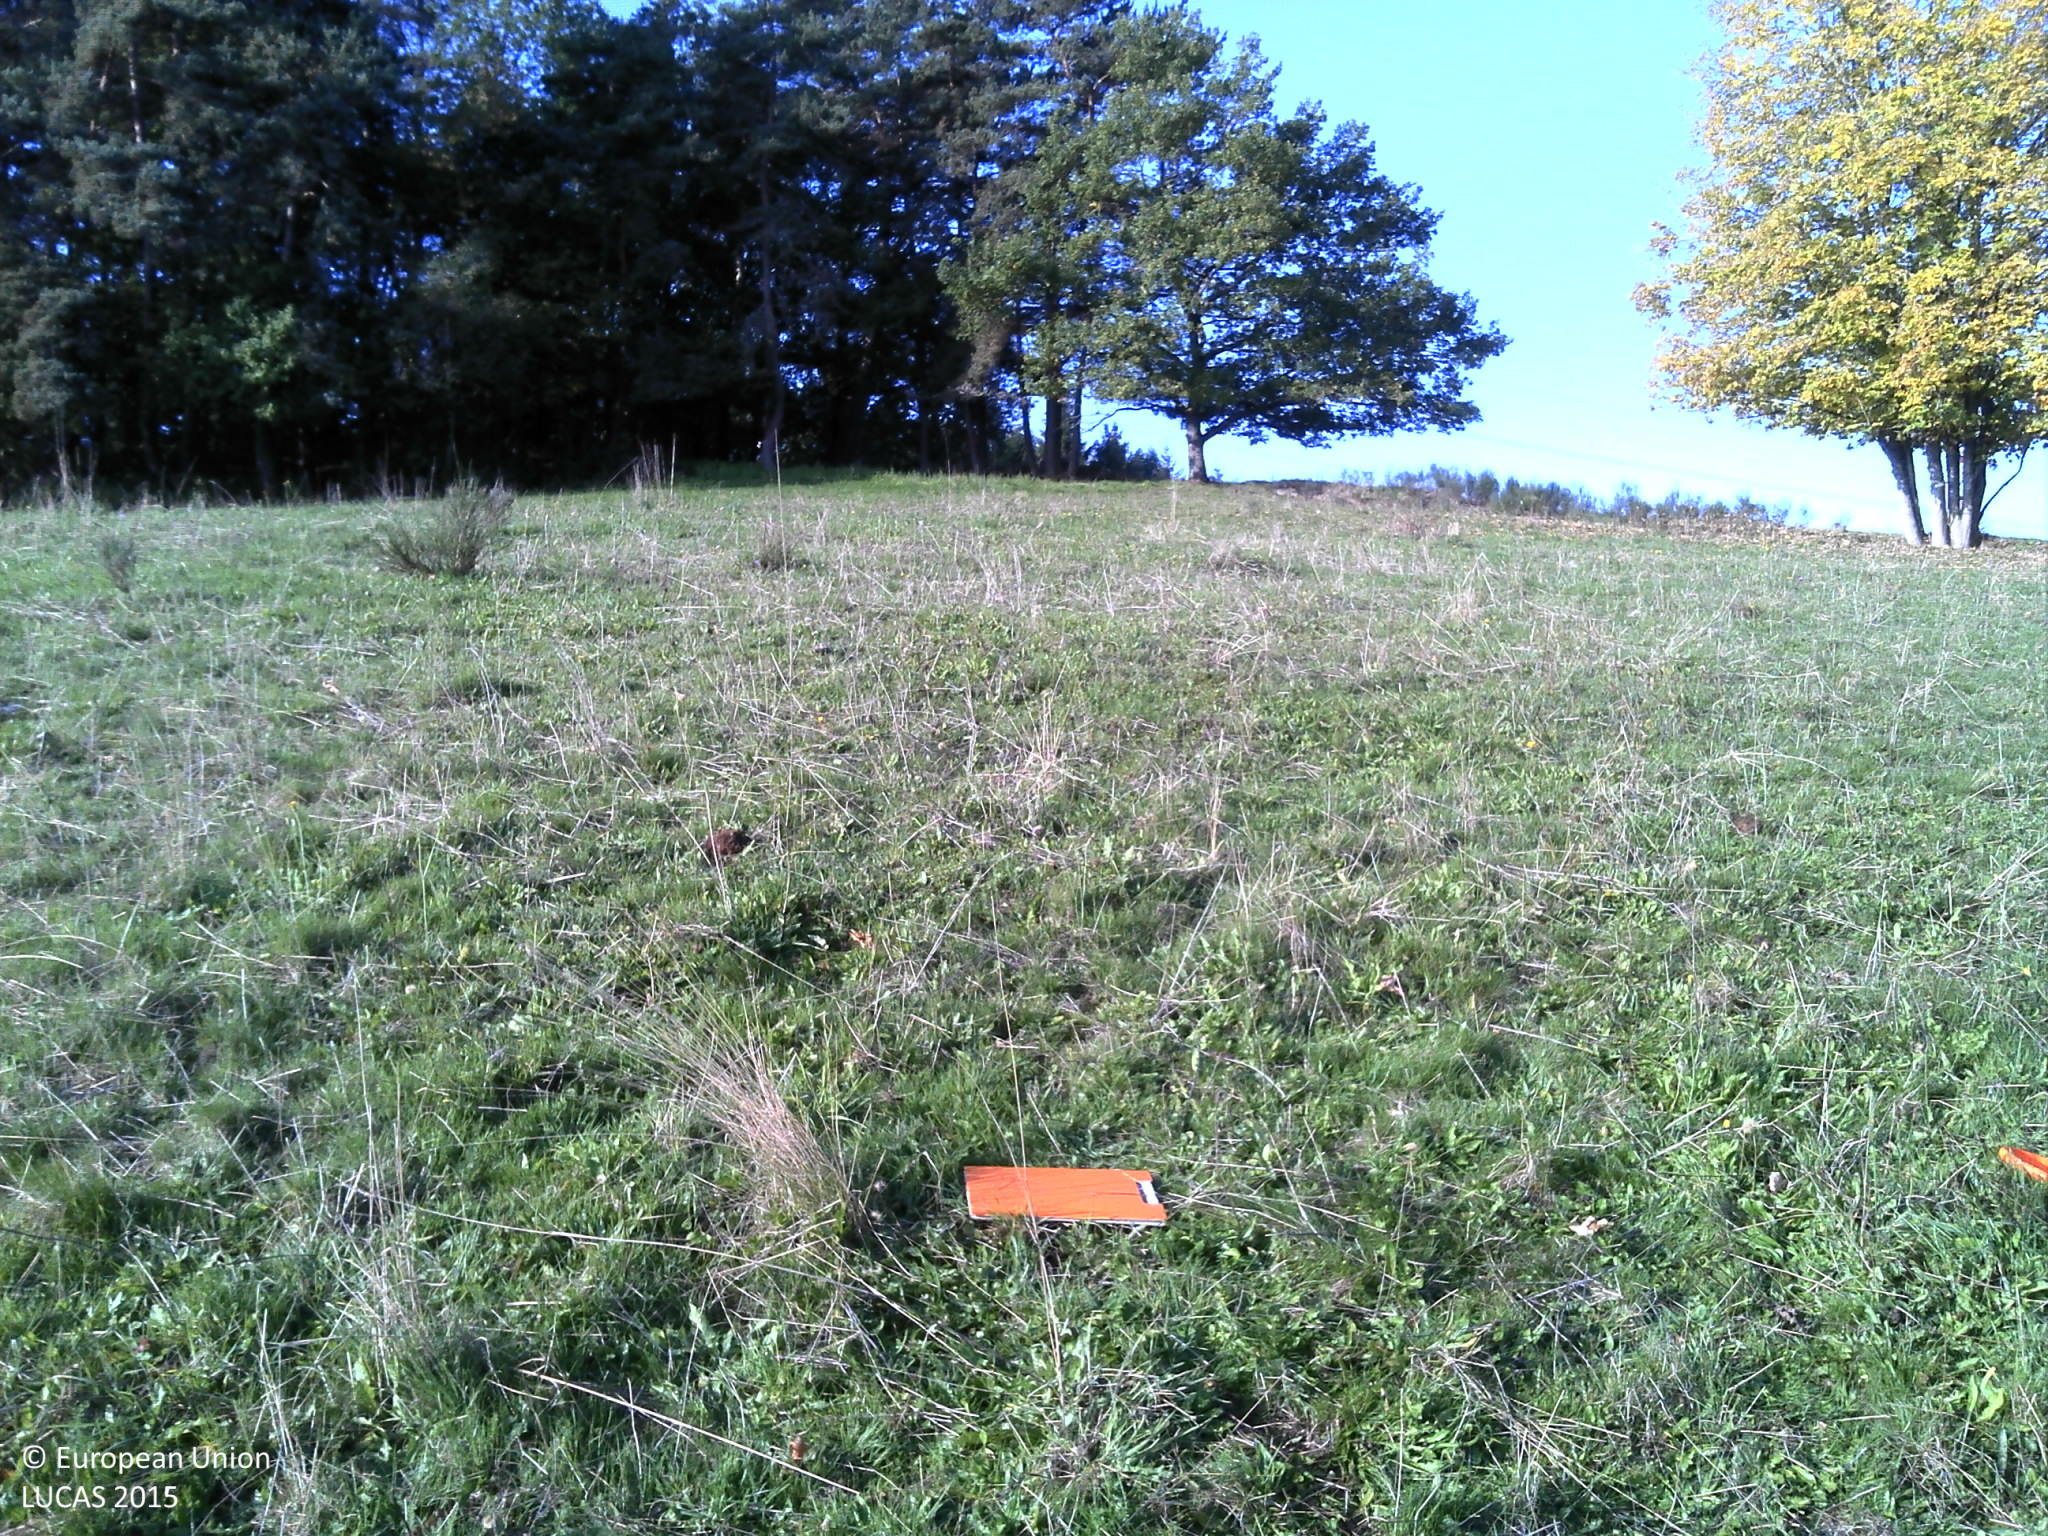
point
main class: Grassland
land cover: Grassland without tree/shrub cover
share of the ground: > 75 %
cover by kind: herbaceous plants 100 %
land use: Agriculture (excluding fallow land and kitchen gardens)
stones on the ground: < 10 %
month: October
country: FR
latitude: 45.5878
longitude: 3.7086
